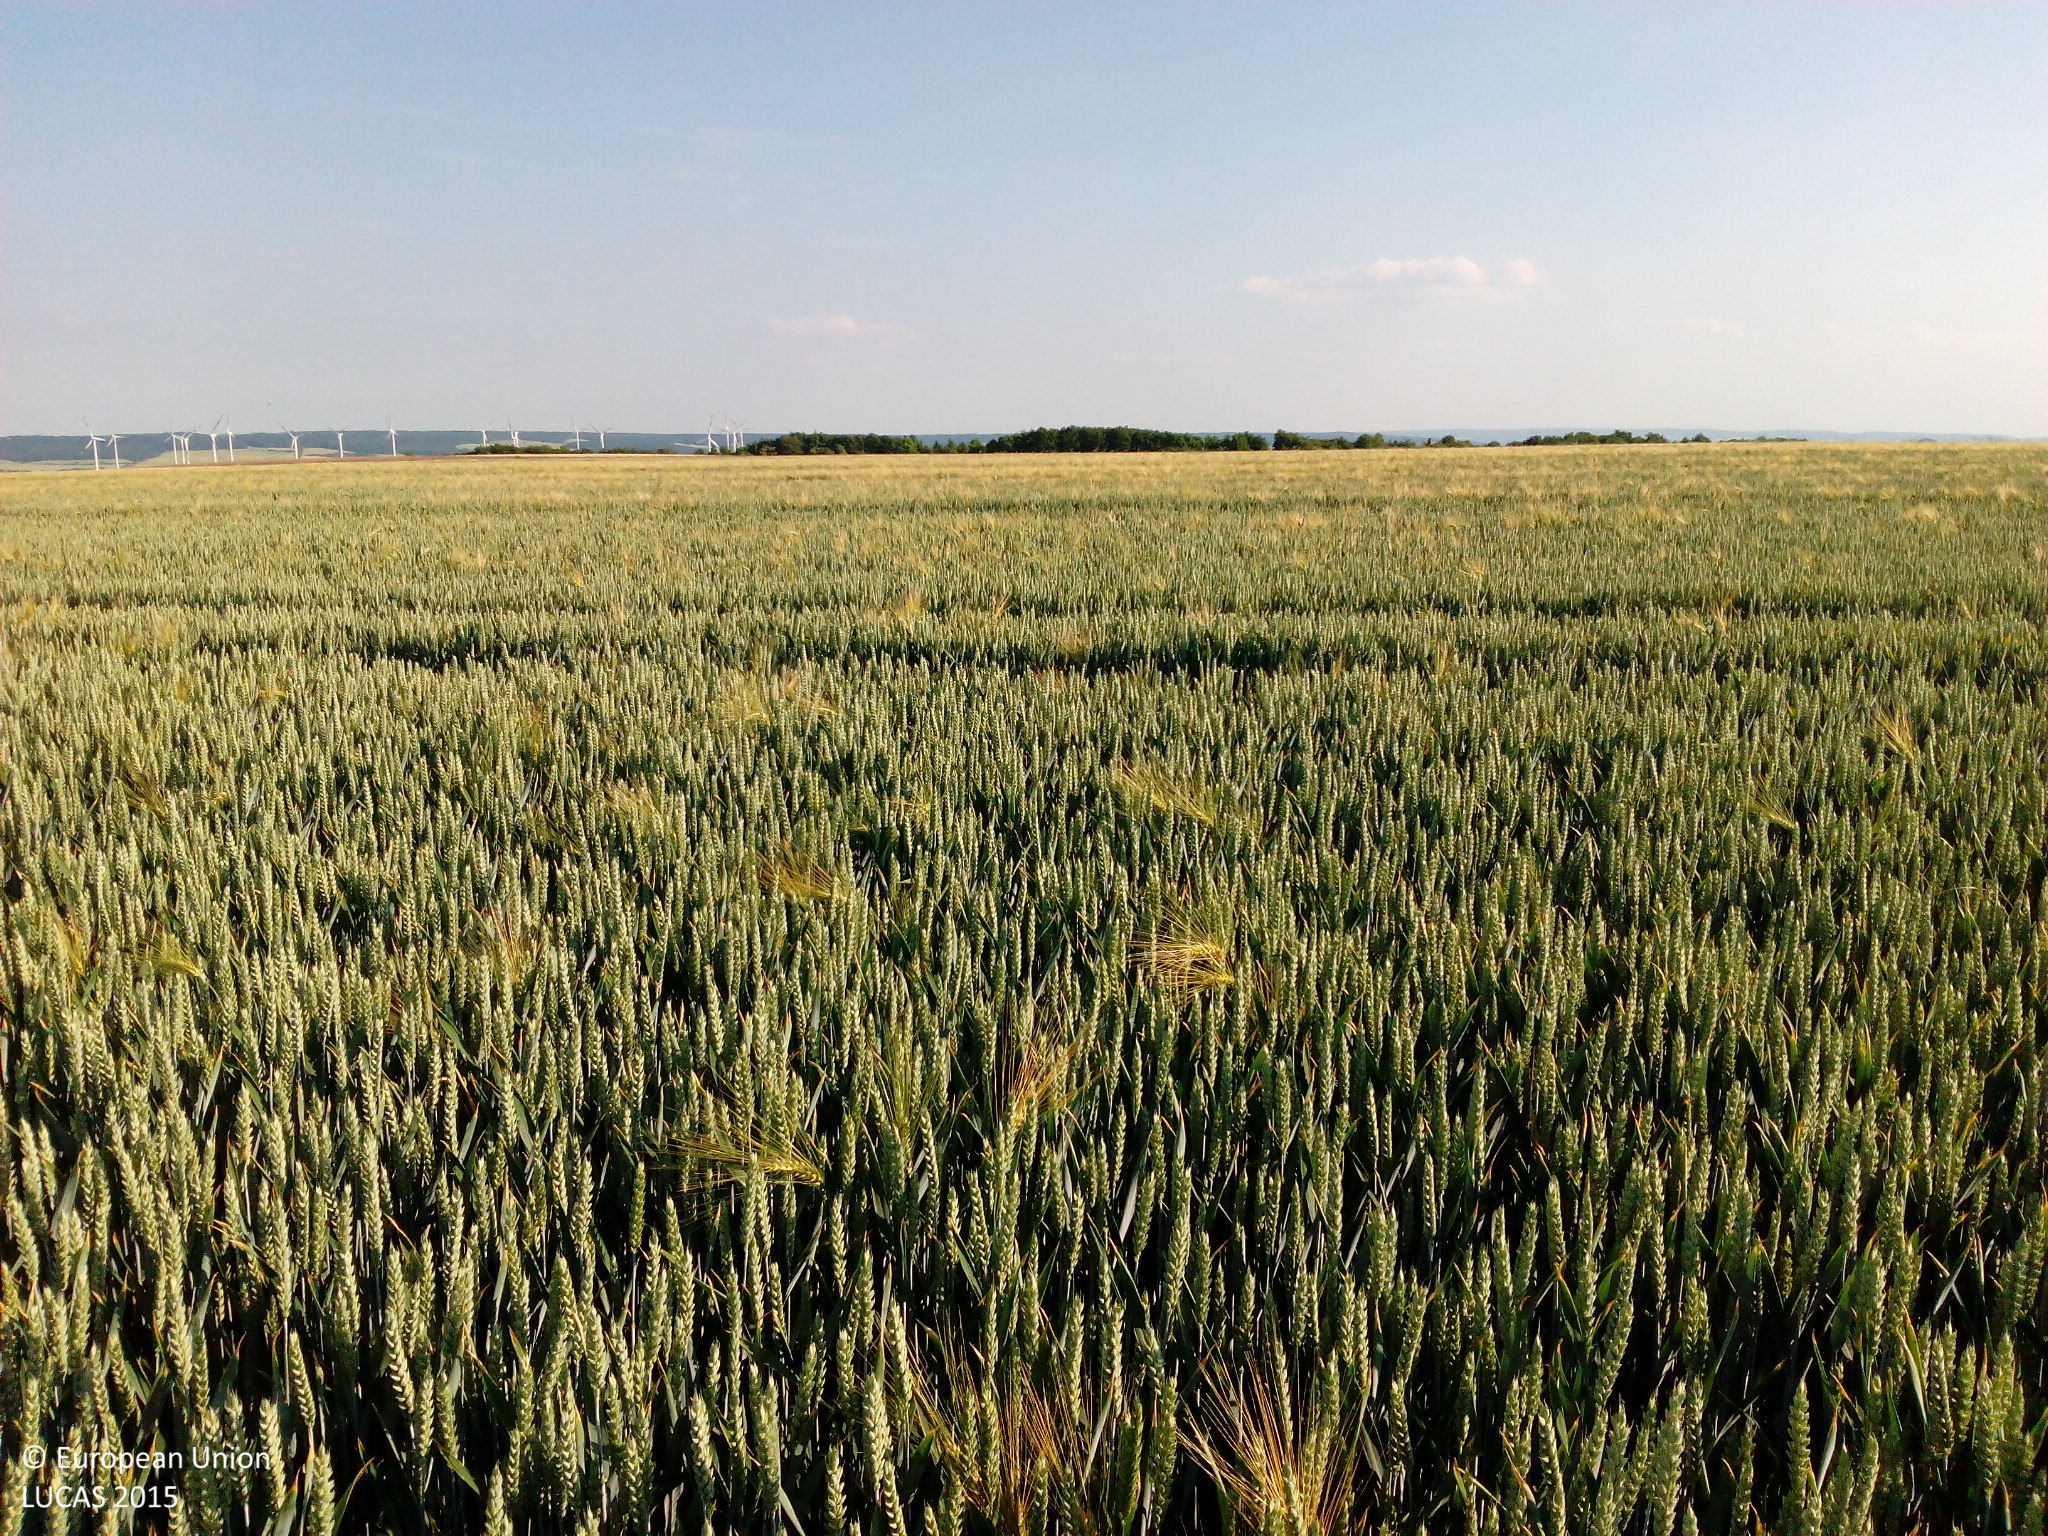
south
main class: Cropland
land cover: Common wheat
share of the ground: 50 - 75 %
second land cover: Barley
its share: 50 - 75 %
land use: Agriculture (excluding fallow land and kitchen gardens)
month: June
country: DE
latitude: 51.4877
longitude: 11.4542
